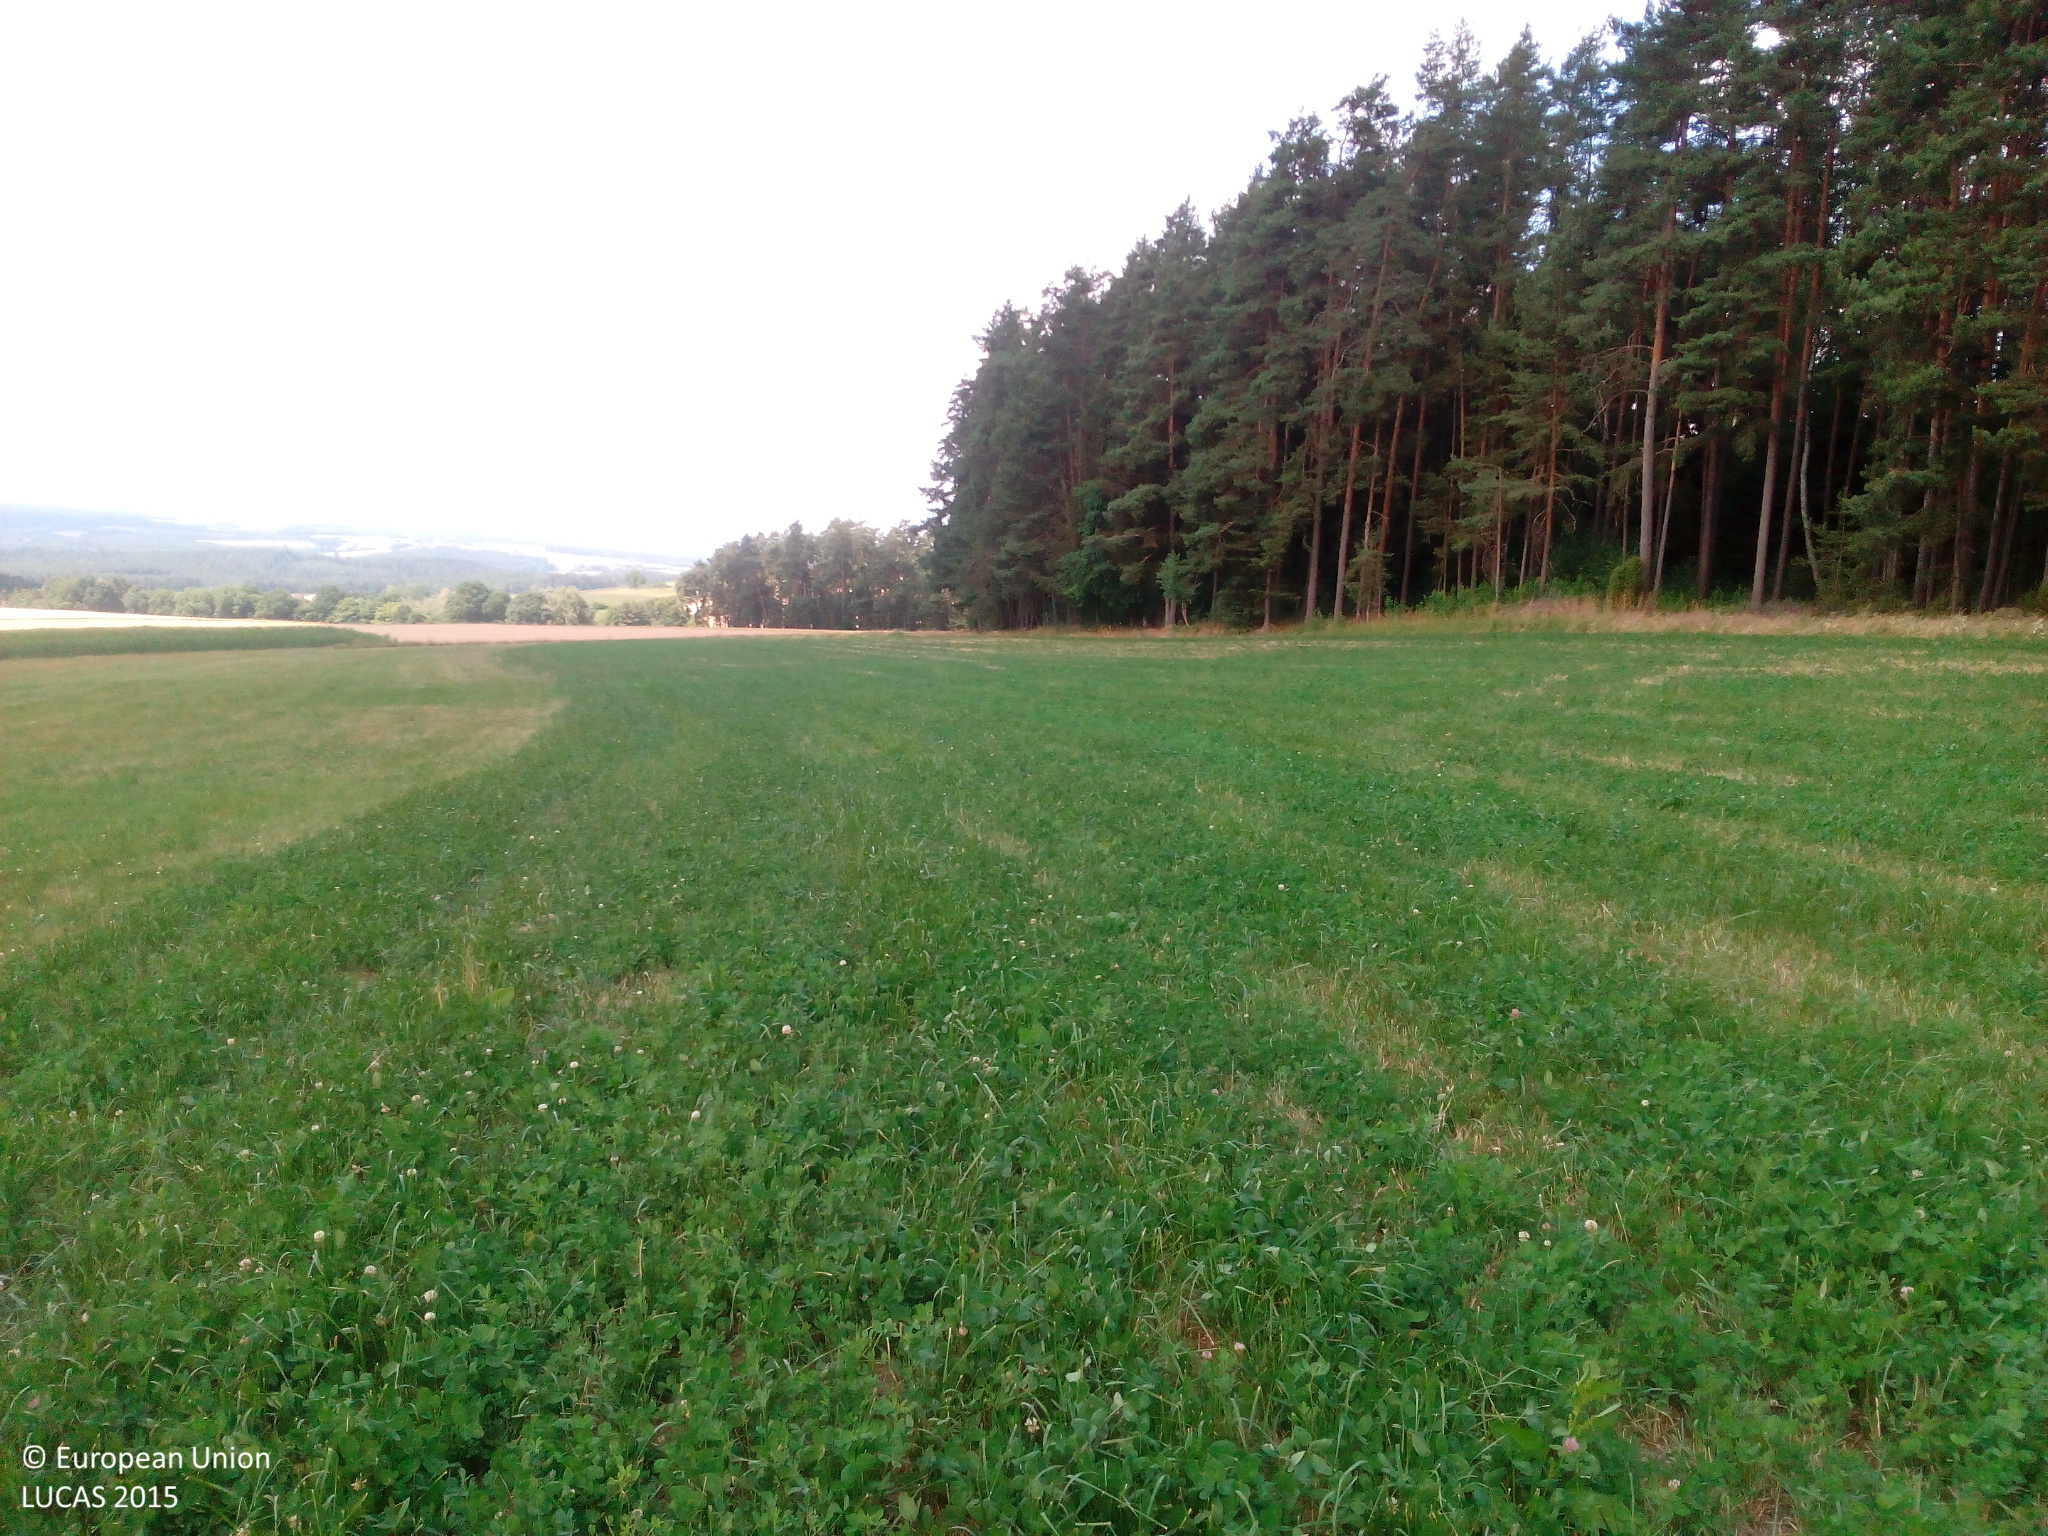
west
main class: Cropland
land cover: Other leguminous and mixtures for fodder
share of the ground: > 75 %
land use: Agriculture (excluding fallow land and kitchen gardens)
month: July
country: DE
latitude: 49.5329
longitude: 12.2241
